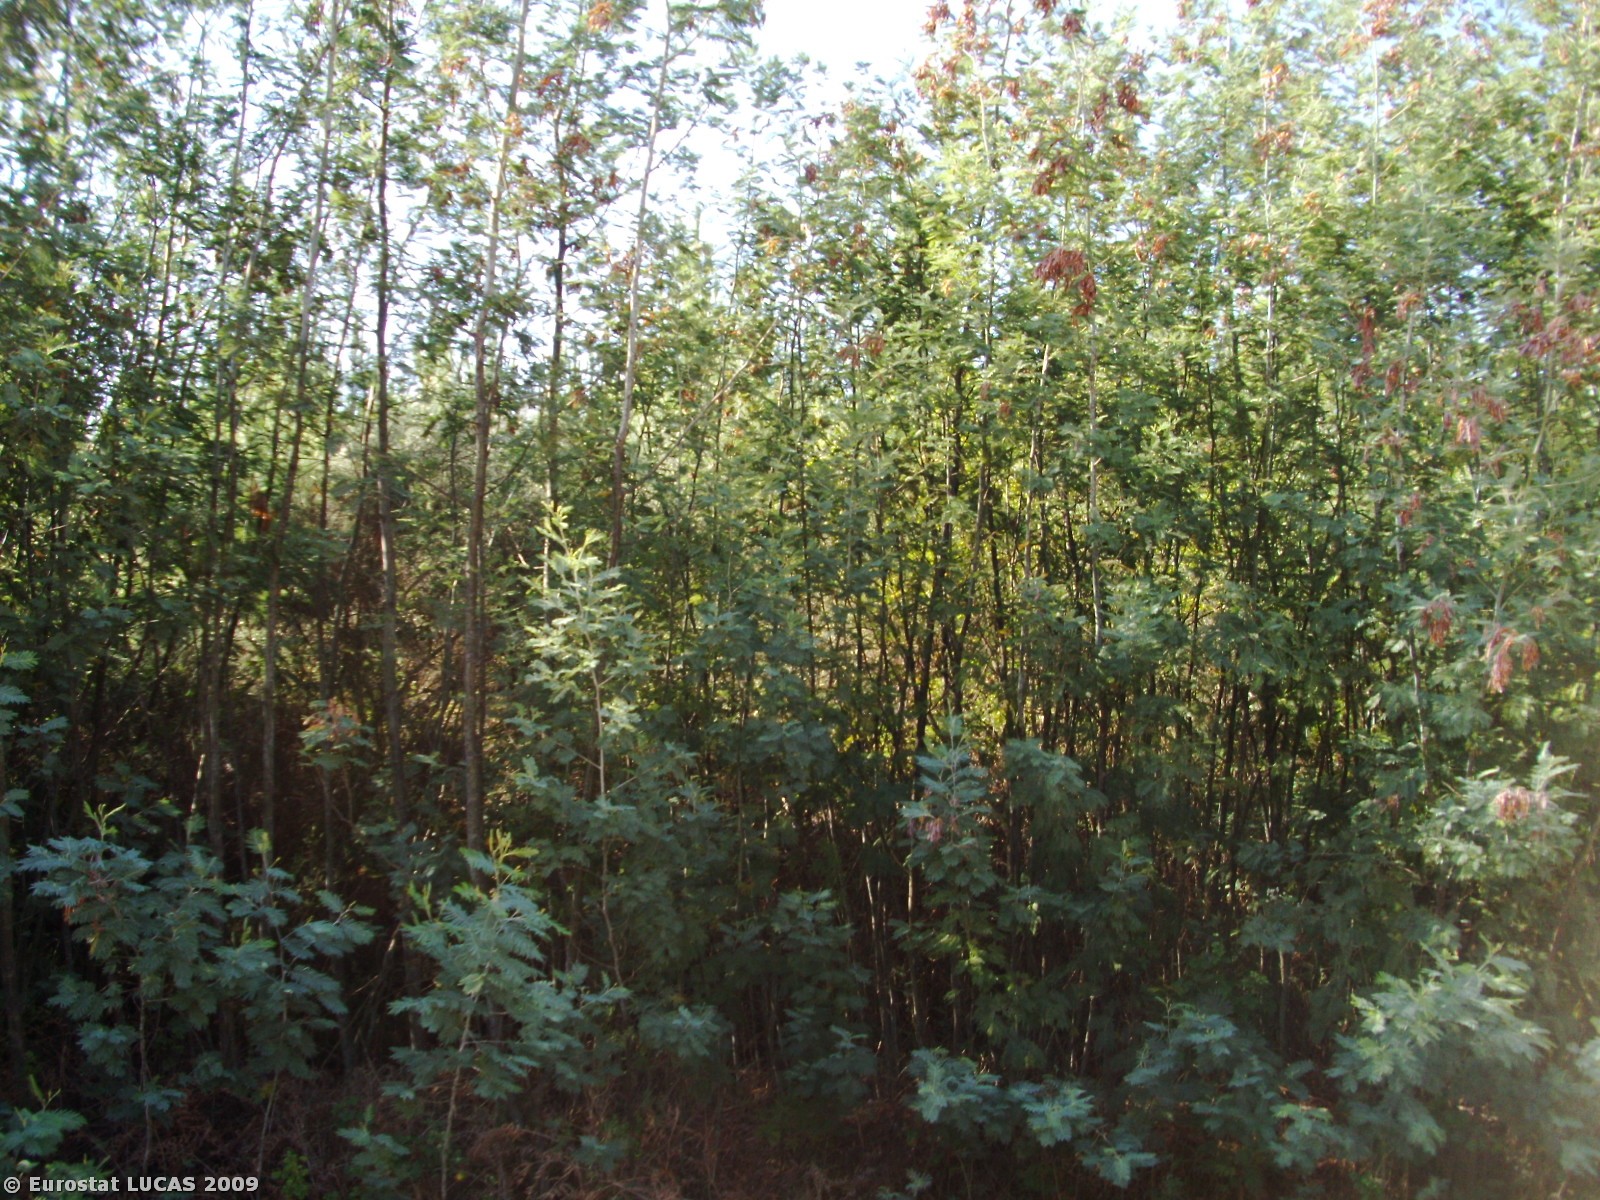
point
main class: Woodland
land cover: Coniferous woodland
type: coniferous forest of the mediterranean region
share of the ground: > 75 %
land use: Forestry
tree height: > 5 m
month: June
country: PT
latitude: 40.1482
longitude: -7.3453
